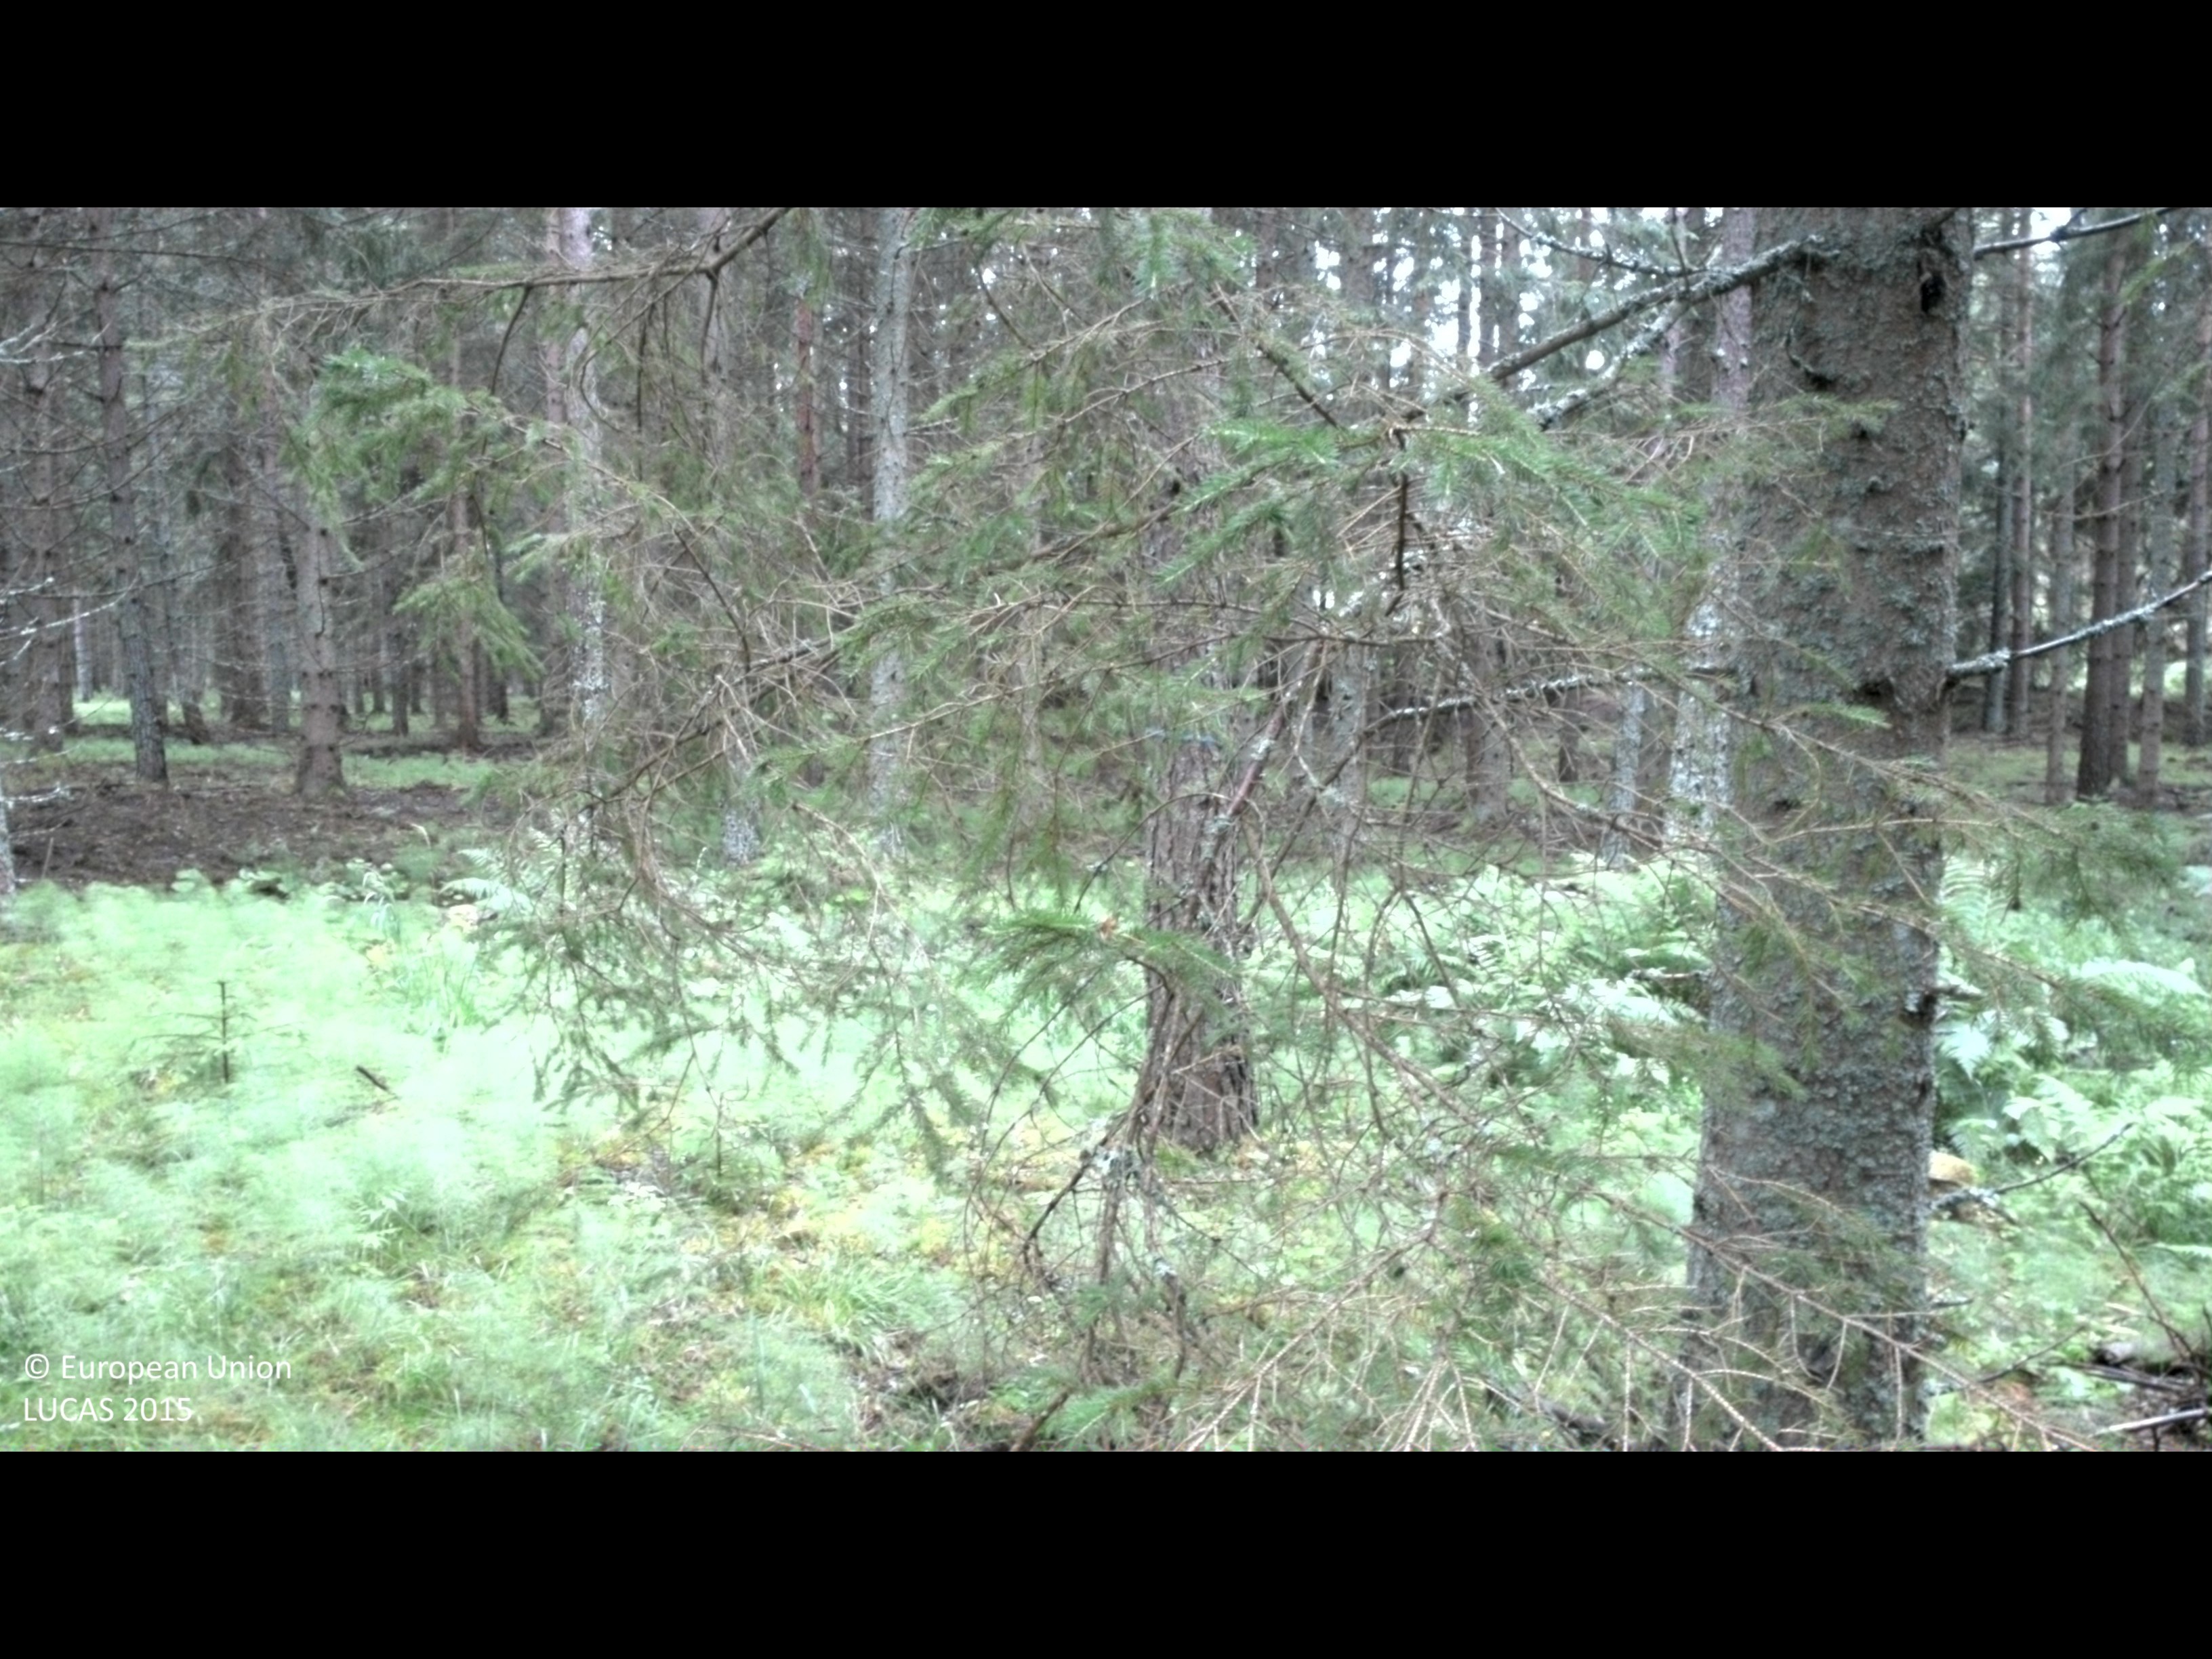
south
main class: Woodland
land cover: Spruce dominated coniferous woodland
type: boreal forest
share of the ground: 50 - 75 %
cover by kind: coniferous forest trees 60 %, herbaceous plants 20 %, lichens and mosses 15 %, shrubs 5 %
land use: Forestry
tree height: > 5 m
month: July
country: SE
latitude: 58.3488
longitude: 16.1638
